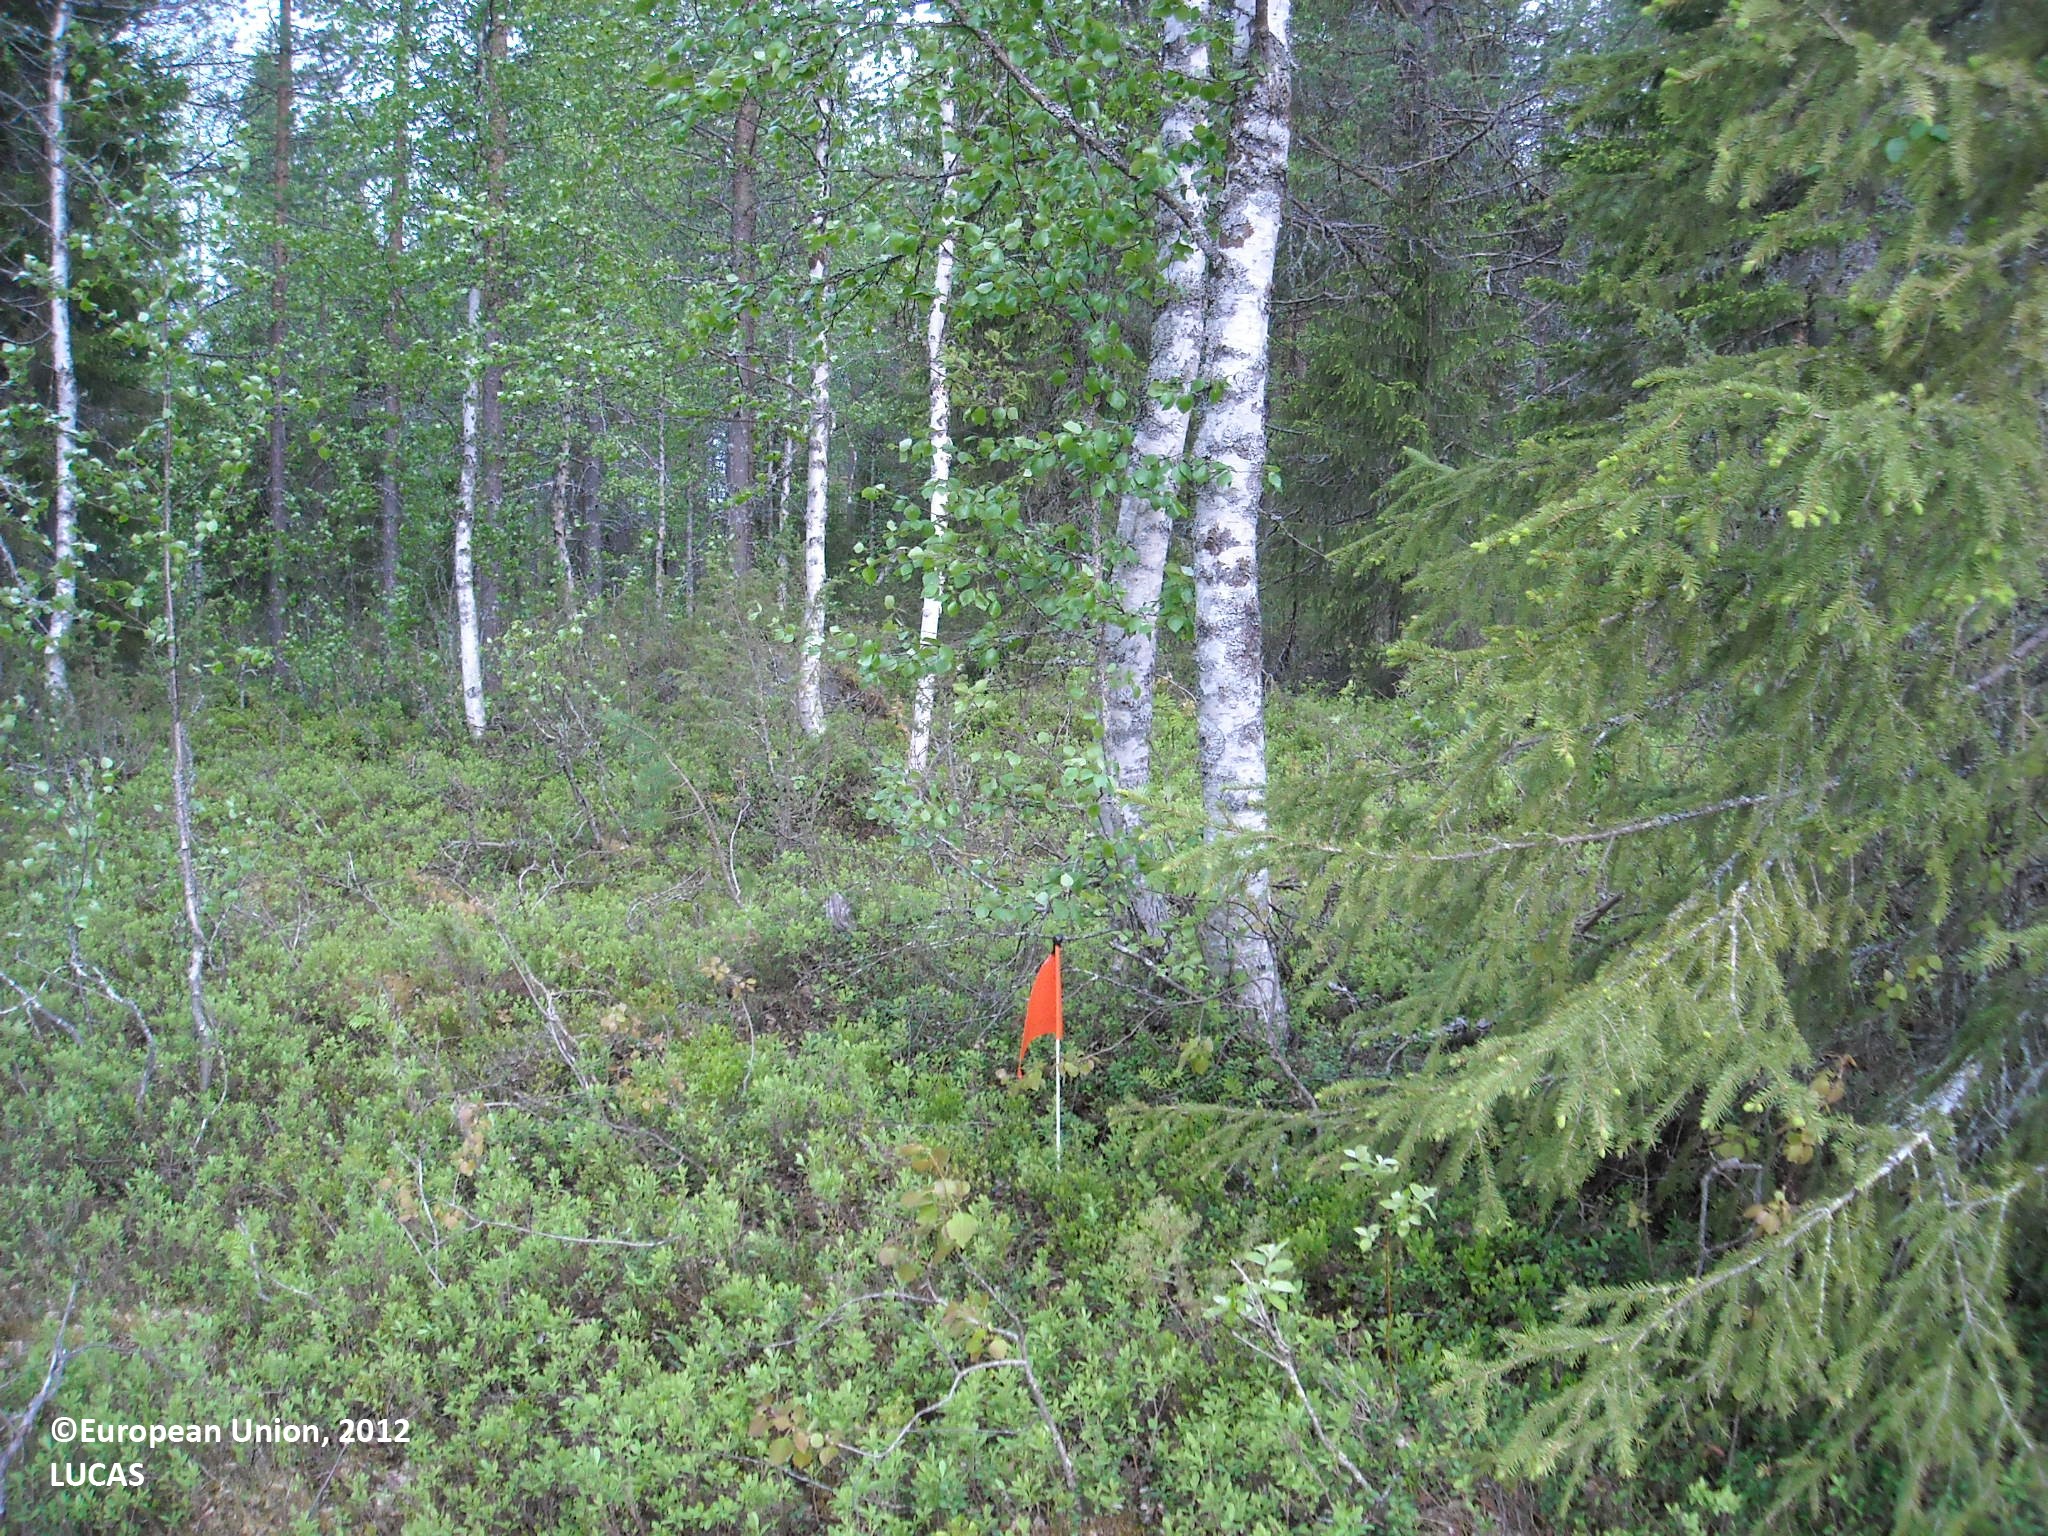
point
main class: Woodland
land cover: Other mixed woodland
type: boreal forest
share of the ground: > 75 %
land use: Forestry
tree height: > 5 m
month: June
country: FI
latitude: 65.6510
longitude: 27.9882
